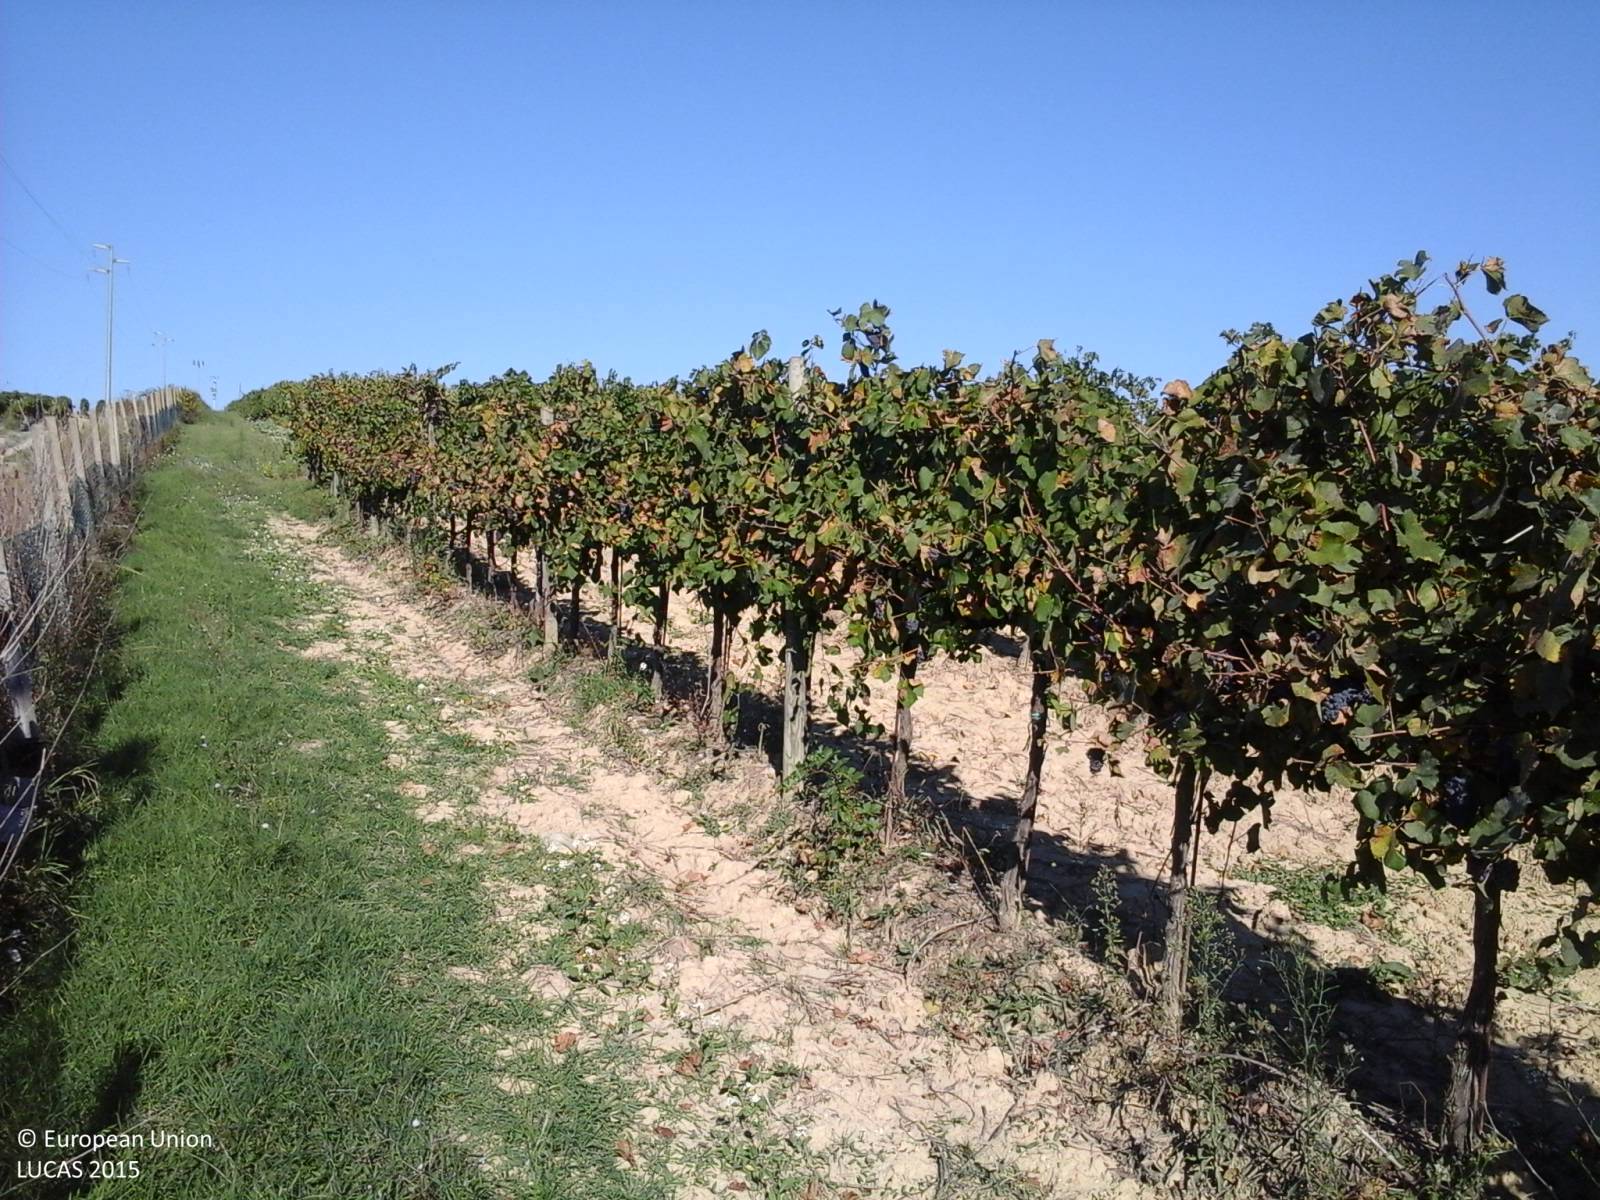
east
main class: Grassland
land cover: Grassland with sparse tree/shrub cover
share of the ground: > 75 %
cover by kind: herbaceous plants 90 %, broadleaved forest trees 5 %, shrubs 5 %
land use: Semi-natural and natural areas not in use
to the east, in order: Grassland with sparse tree/shrub cover; Tracks; Shruby margins; Fences; Shruby margins; Vineyards; Tracks; Fences; Ditches and canals; Tracks; Fences; Electric lines; Vineyards
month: September
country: IT
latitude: 42.7776
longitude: 12.0591
